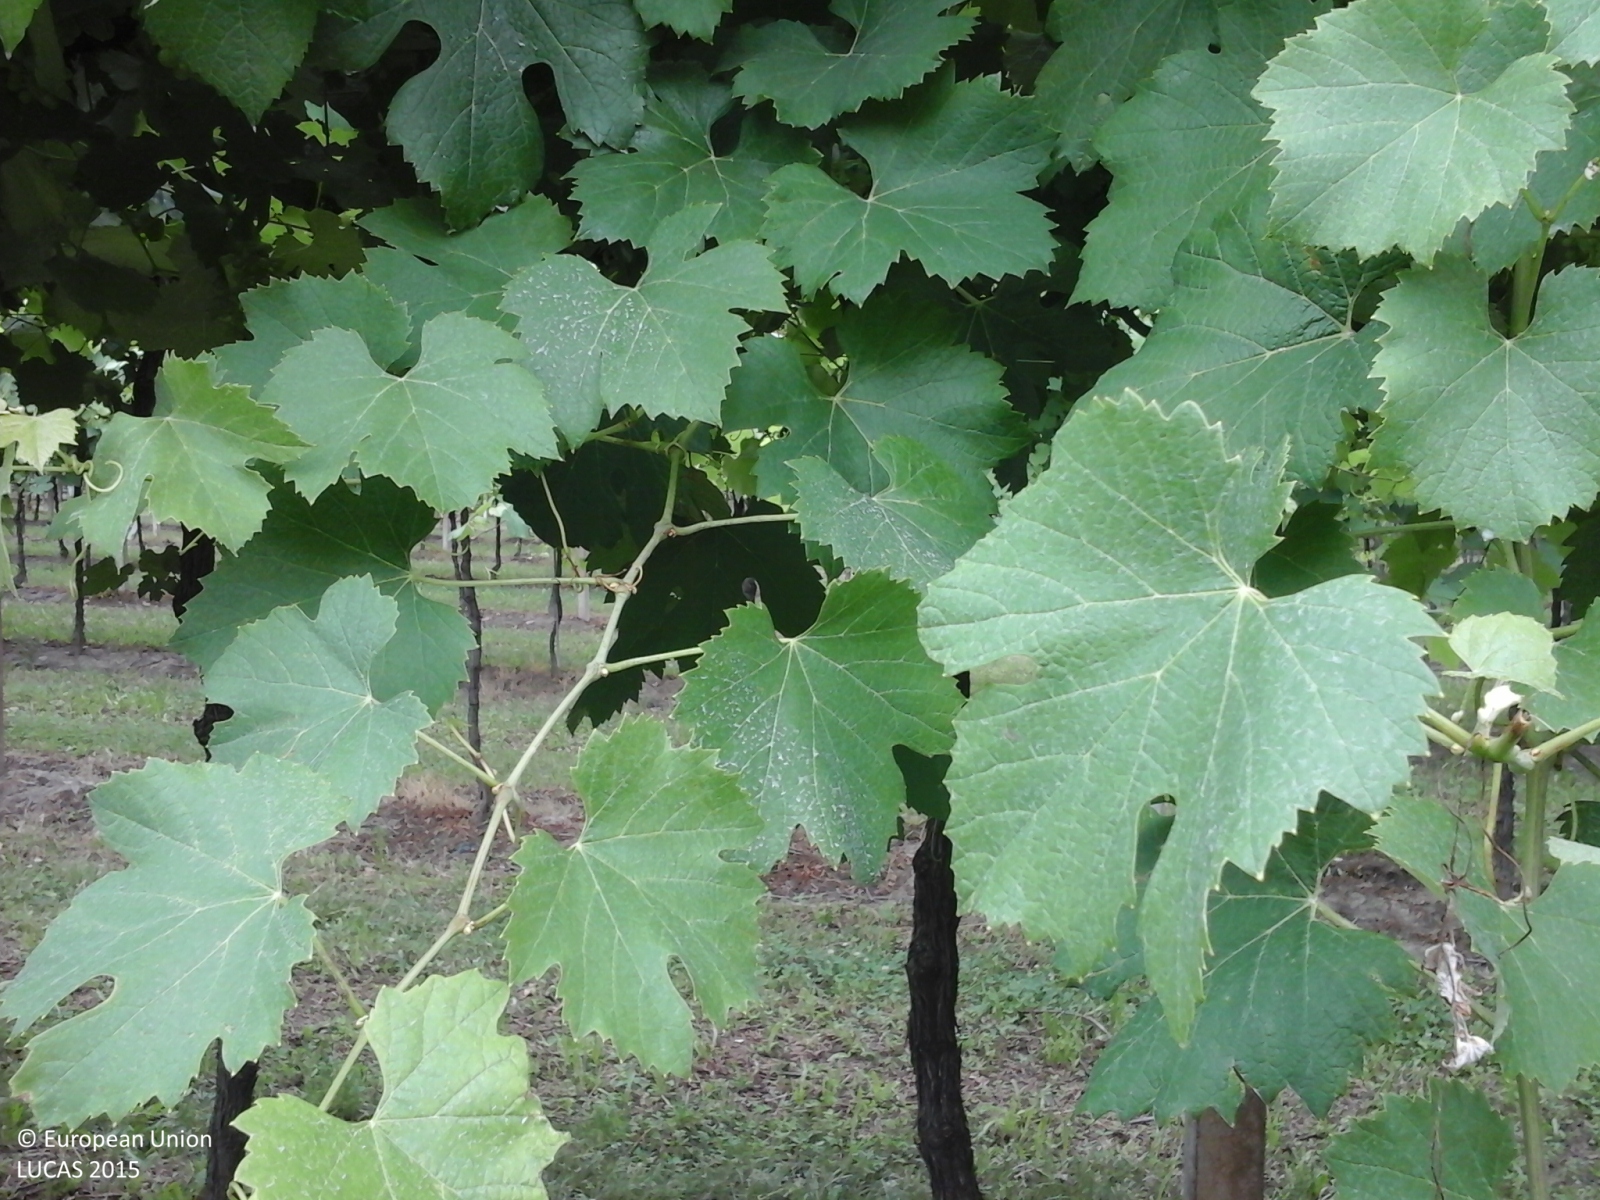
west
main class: Cropland
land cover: Vineyards
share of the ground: 50 - 75 %
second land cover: Grassland without tree/shrub cover
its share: > 75 %
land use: Agriculture (excluding fallow land and kitchen gardens)
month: June
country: IT
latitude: 44.7062
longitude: 11.0202
